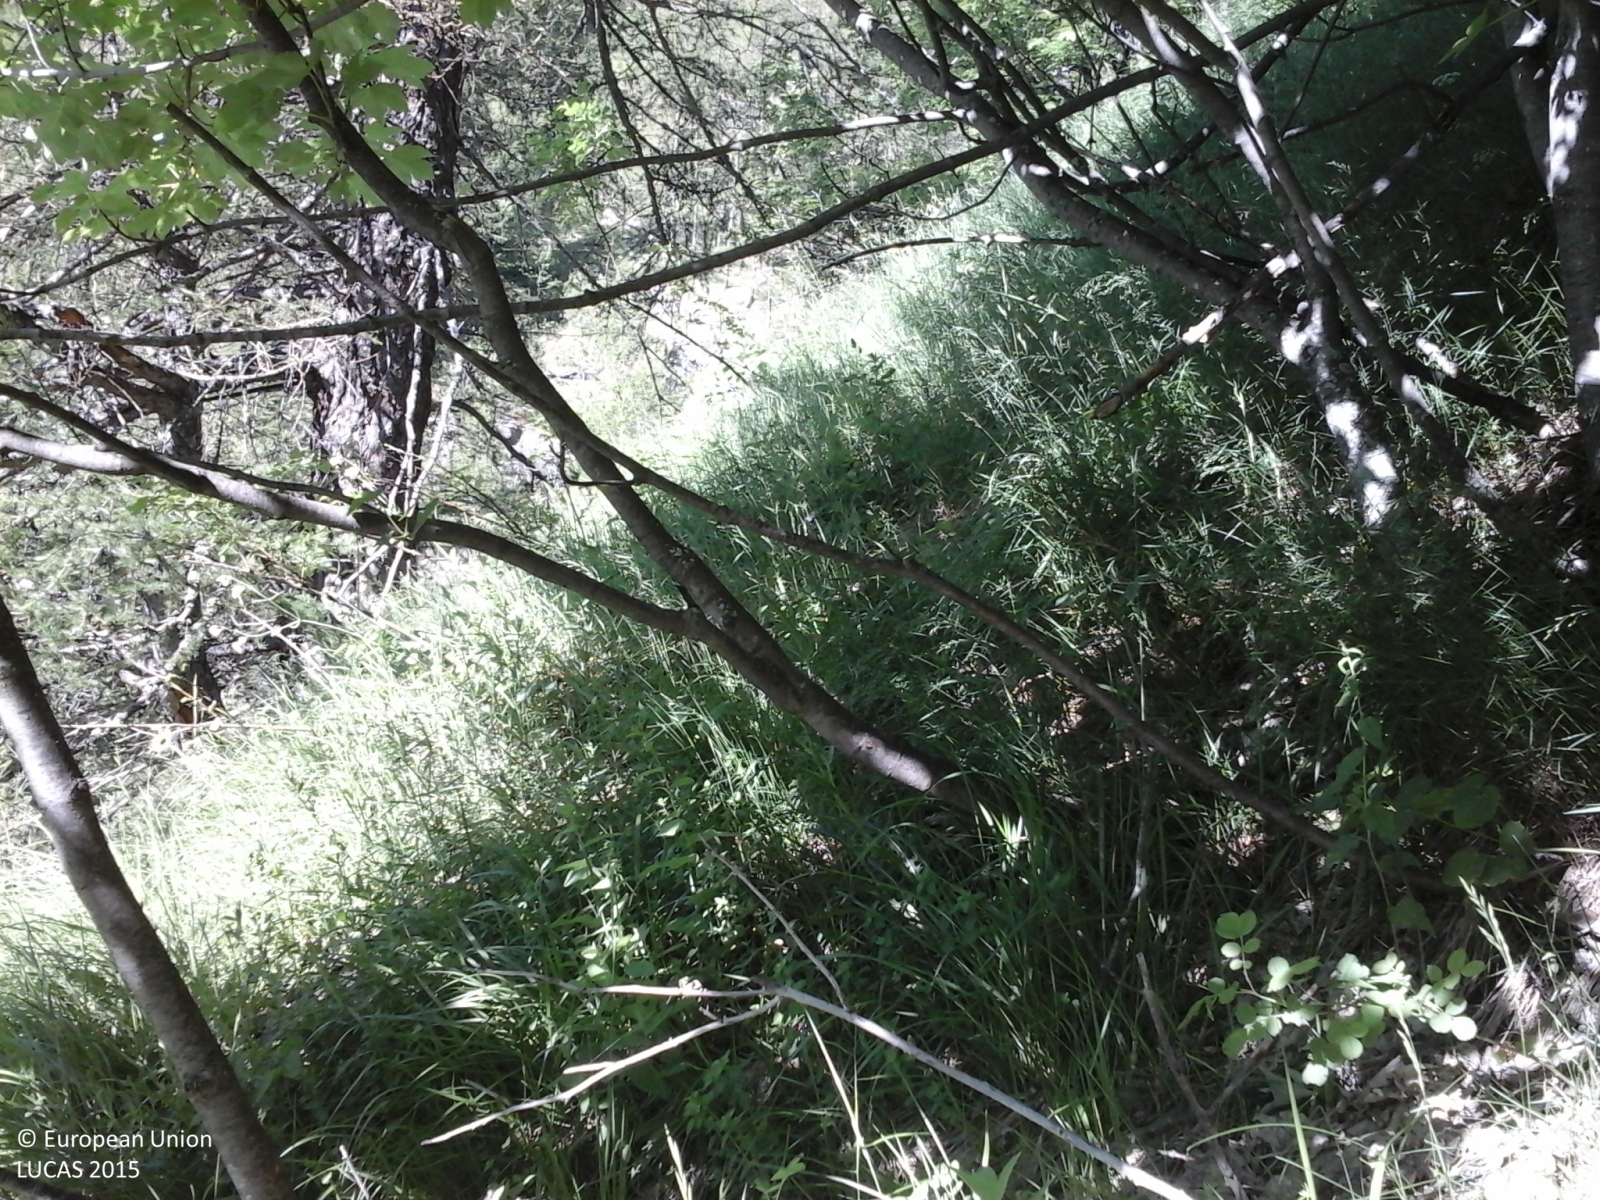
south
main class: Woodland
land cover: Other mixed woodland
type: alpine coniferous forest
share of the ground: > 75 %
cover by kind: coniferous forest trees 45 %, broadleaved forest trees 45 %, herbaceous plants 10 %
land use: Semi-natural and natural areas not in use
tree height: > 5 m
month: June
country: IT
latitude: 45.1097
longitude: 6.6878
